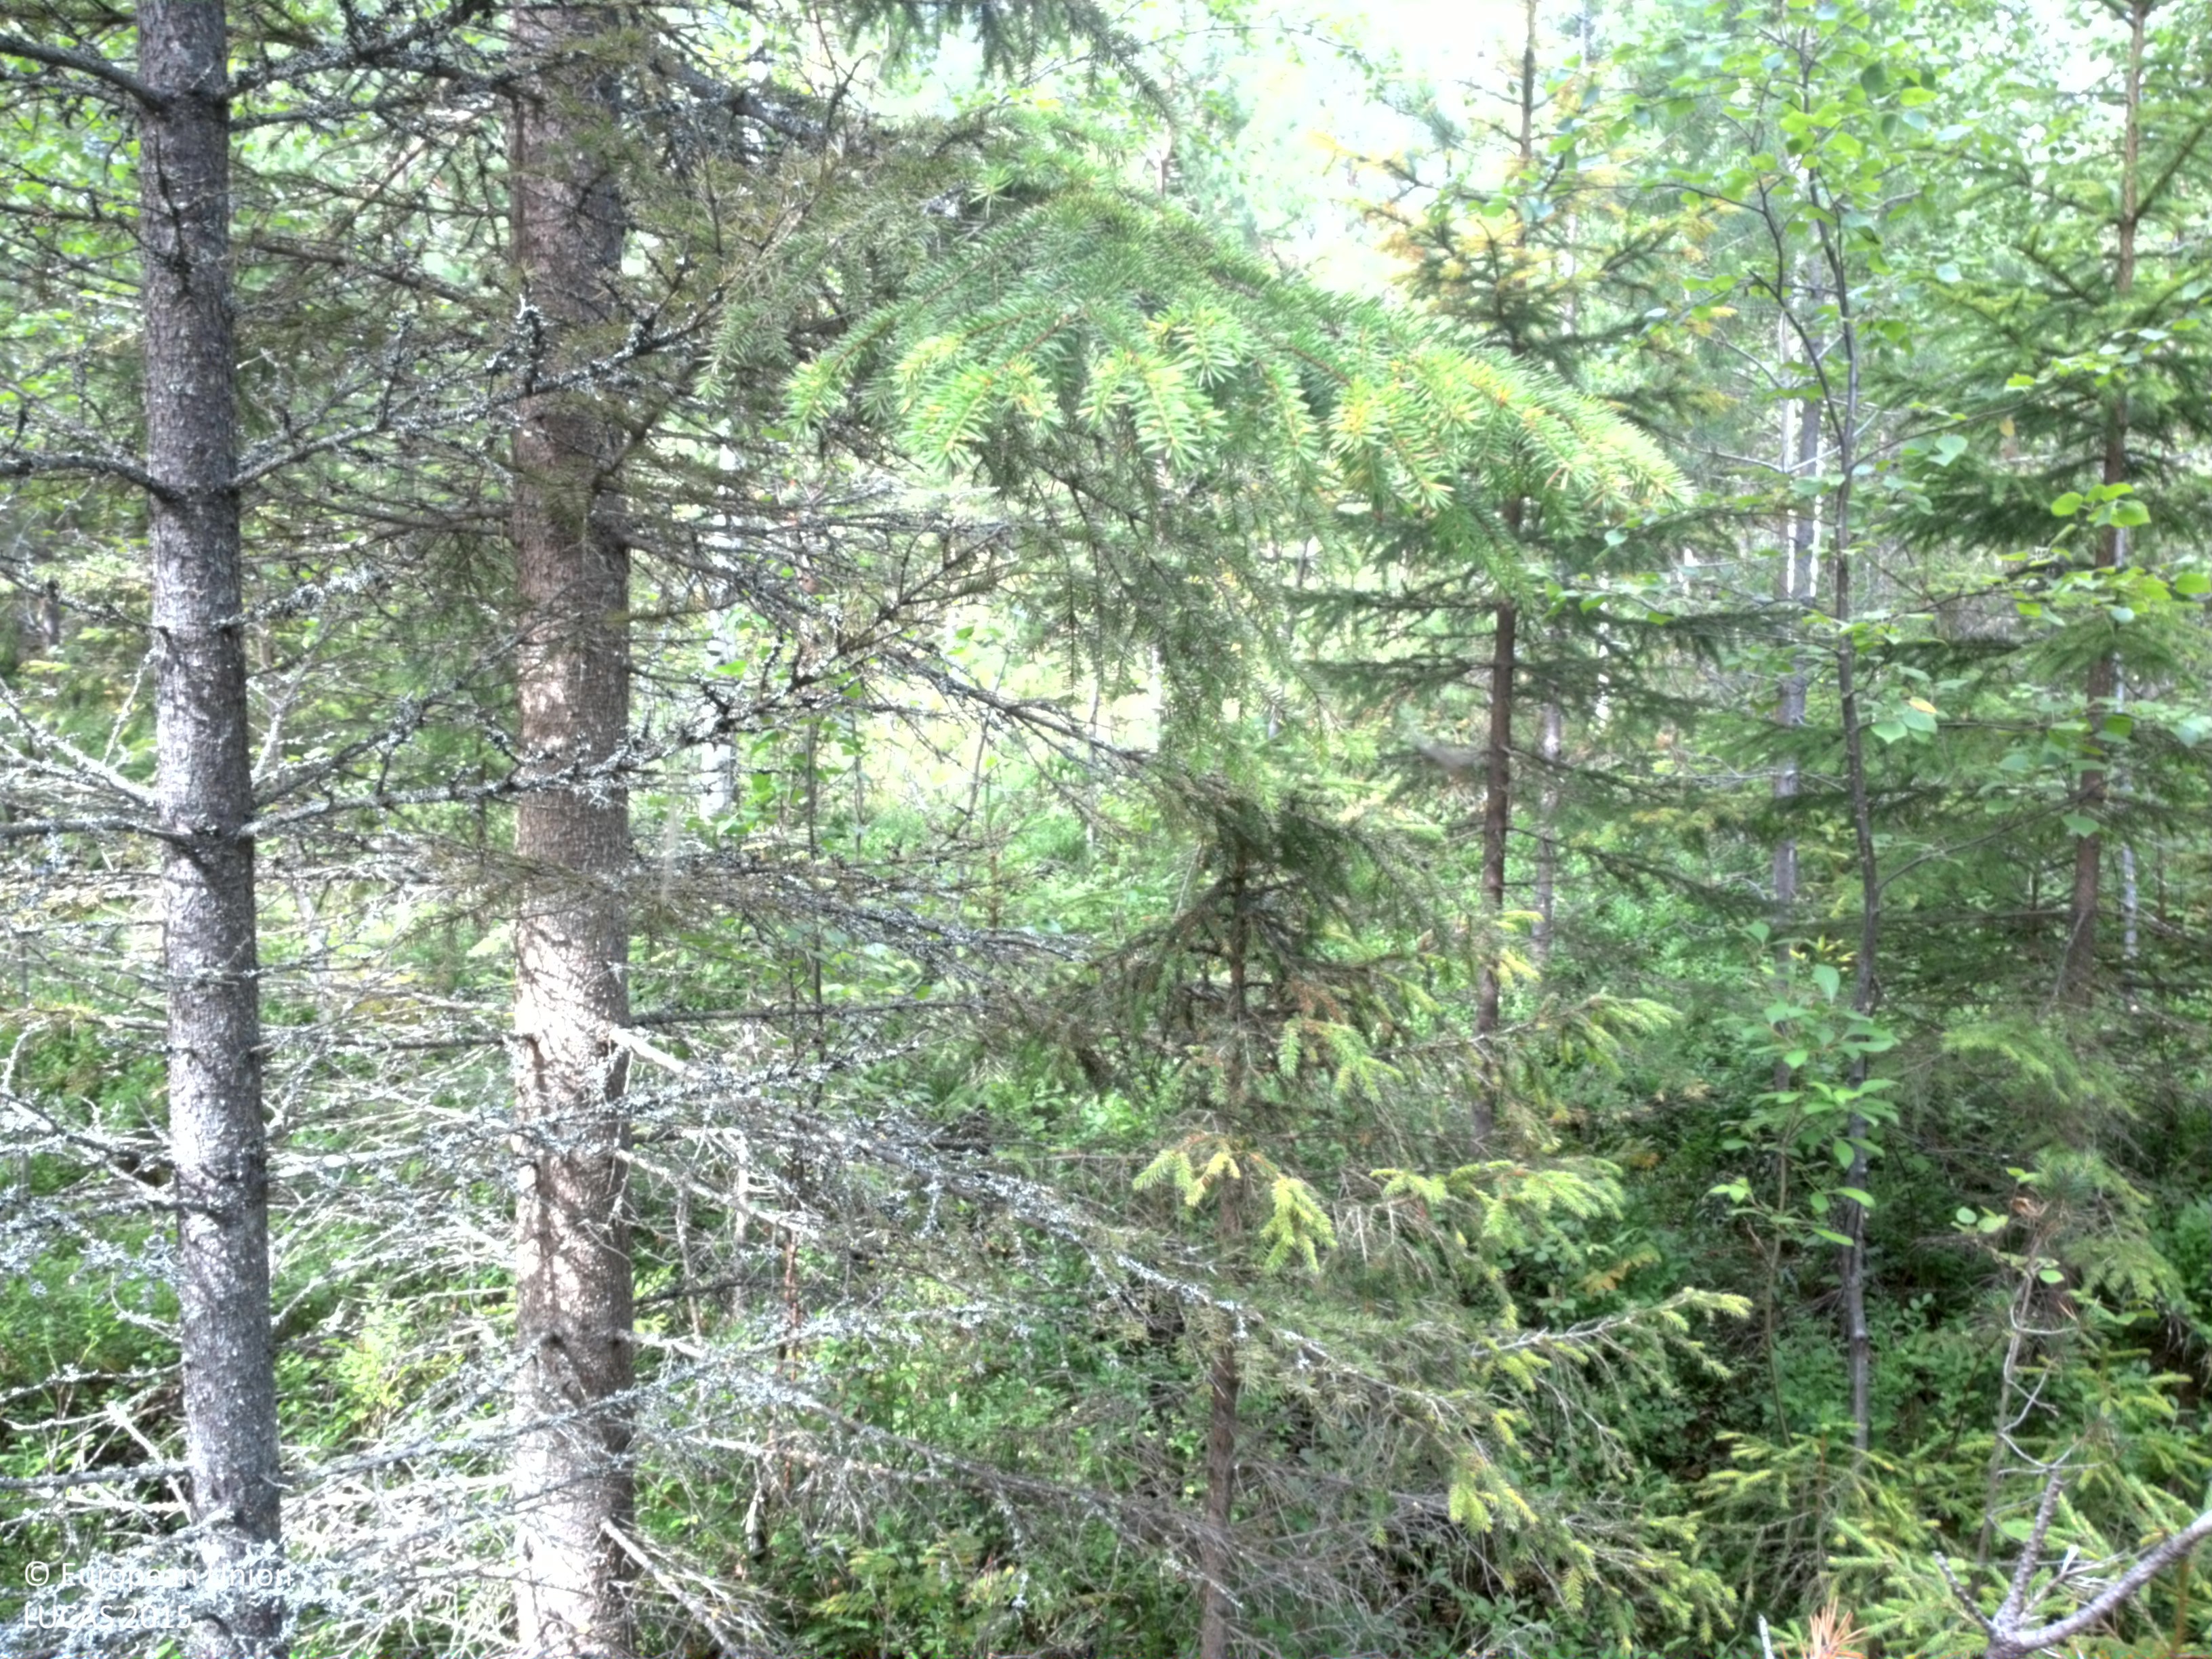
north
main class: Woodland
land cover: Other mixed woodland
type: boreal forest
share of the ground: 50 - 75 %
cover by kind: coniferous forest trees 45 %, shrubs 40 %, broadleaved forest trees 15 %
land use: Forestry
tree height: > 5 m
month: August
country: SE
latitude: 64.6263
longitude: 20.8754
